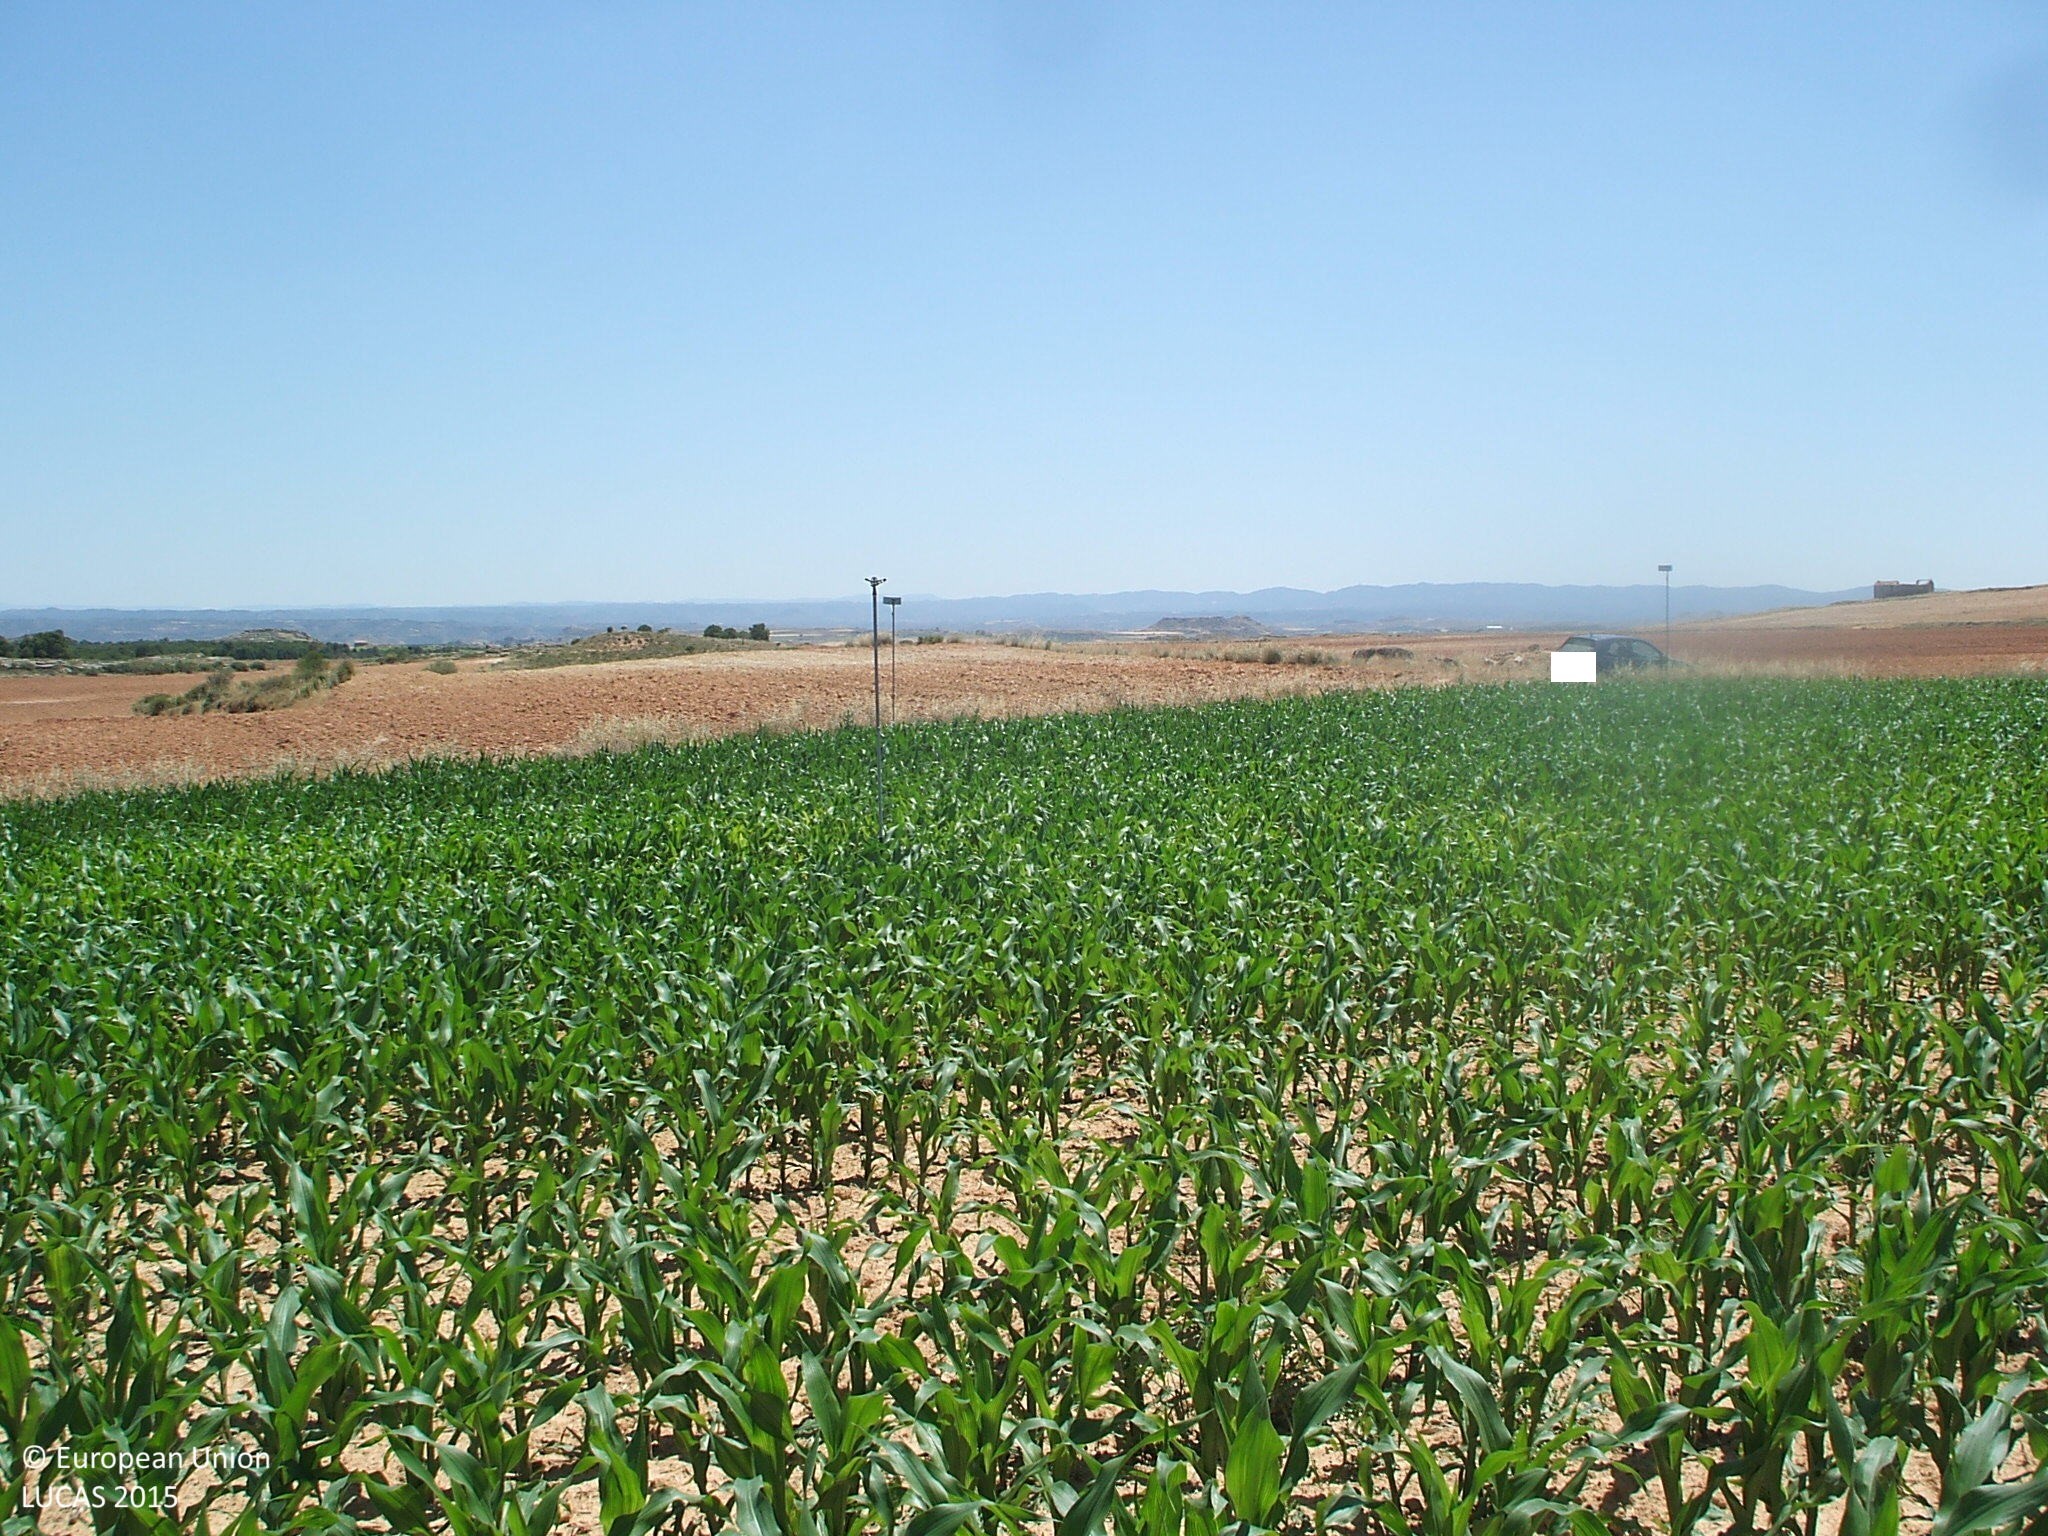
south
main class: Cropland
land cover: Maize
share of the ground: 50 - 75 %
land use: Agriculture (excluding fallow land and kitchen gardens)
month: June
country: ES
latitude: 41.0631
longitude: -0.2101
